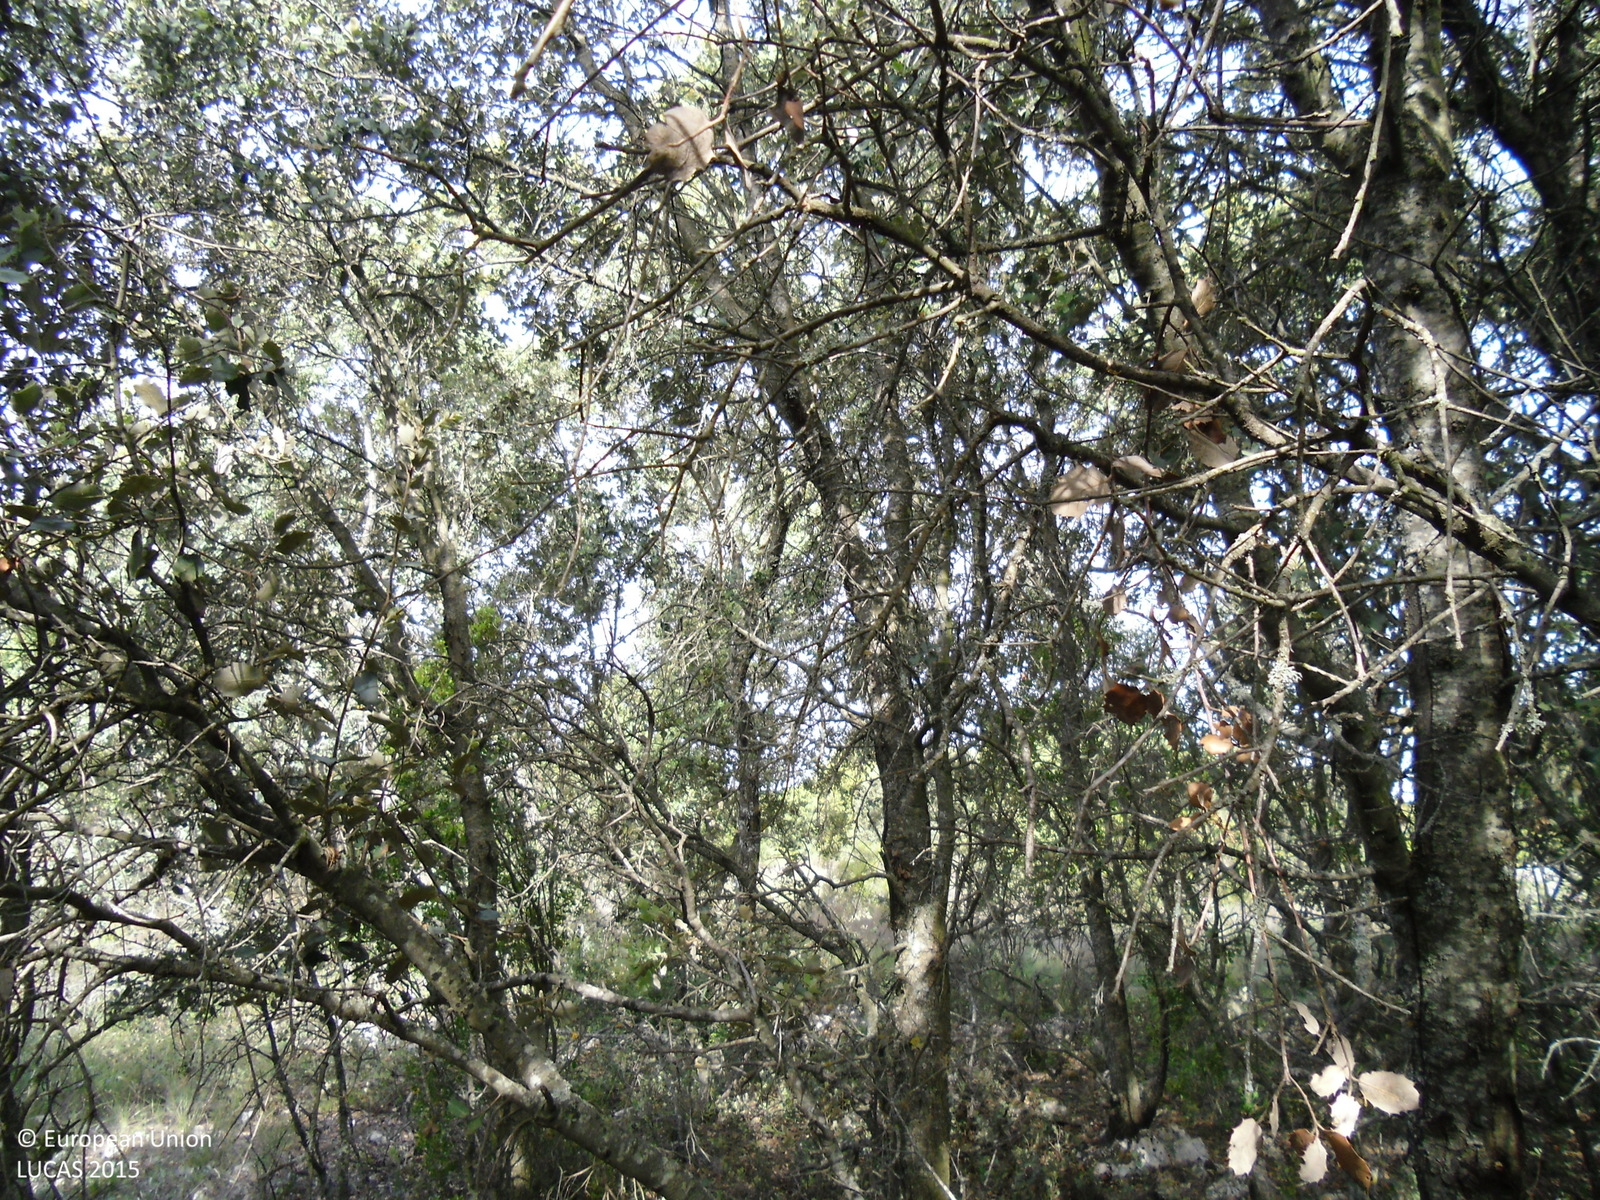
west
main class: Woodland
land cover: Broadleaved woodland
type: thermophilous deciduous forest
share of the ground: > 75 %
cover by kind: broadleaved forest trees 95 %, herbaceous plants 5 %
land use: Semi-natural and natural areas not in use
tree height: > 5 m
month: May
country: ES
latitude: 40.4733
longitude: -2.8967
